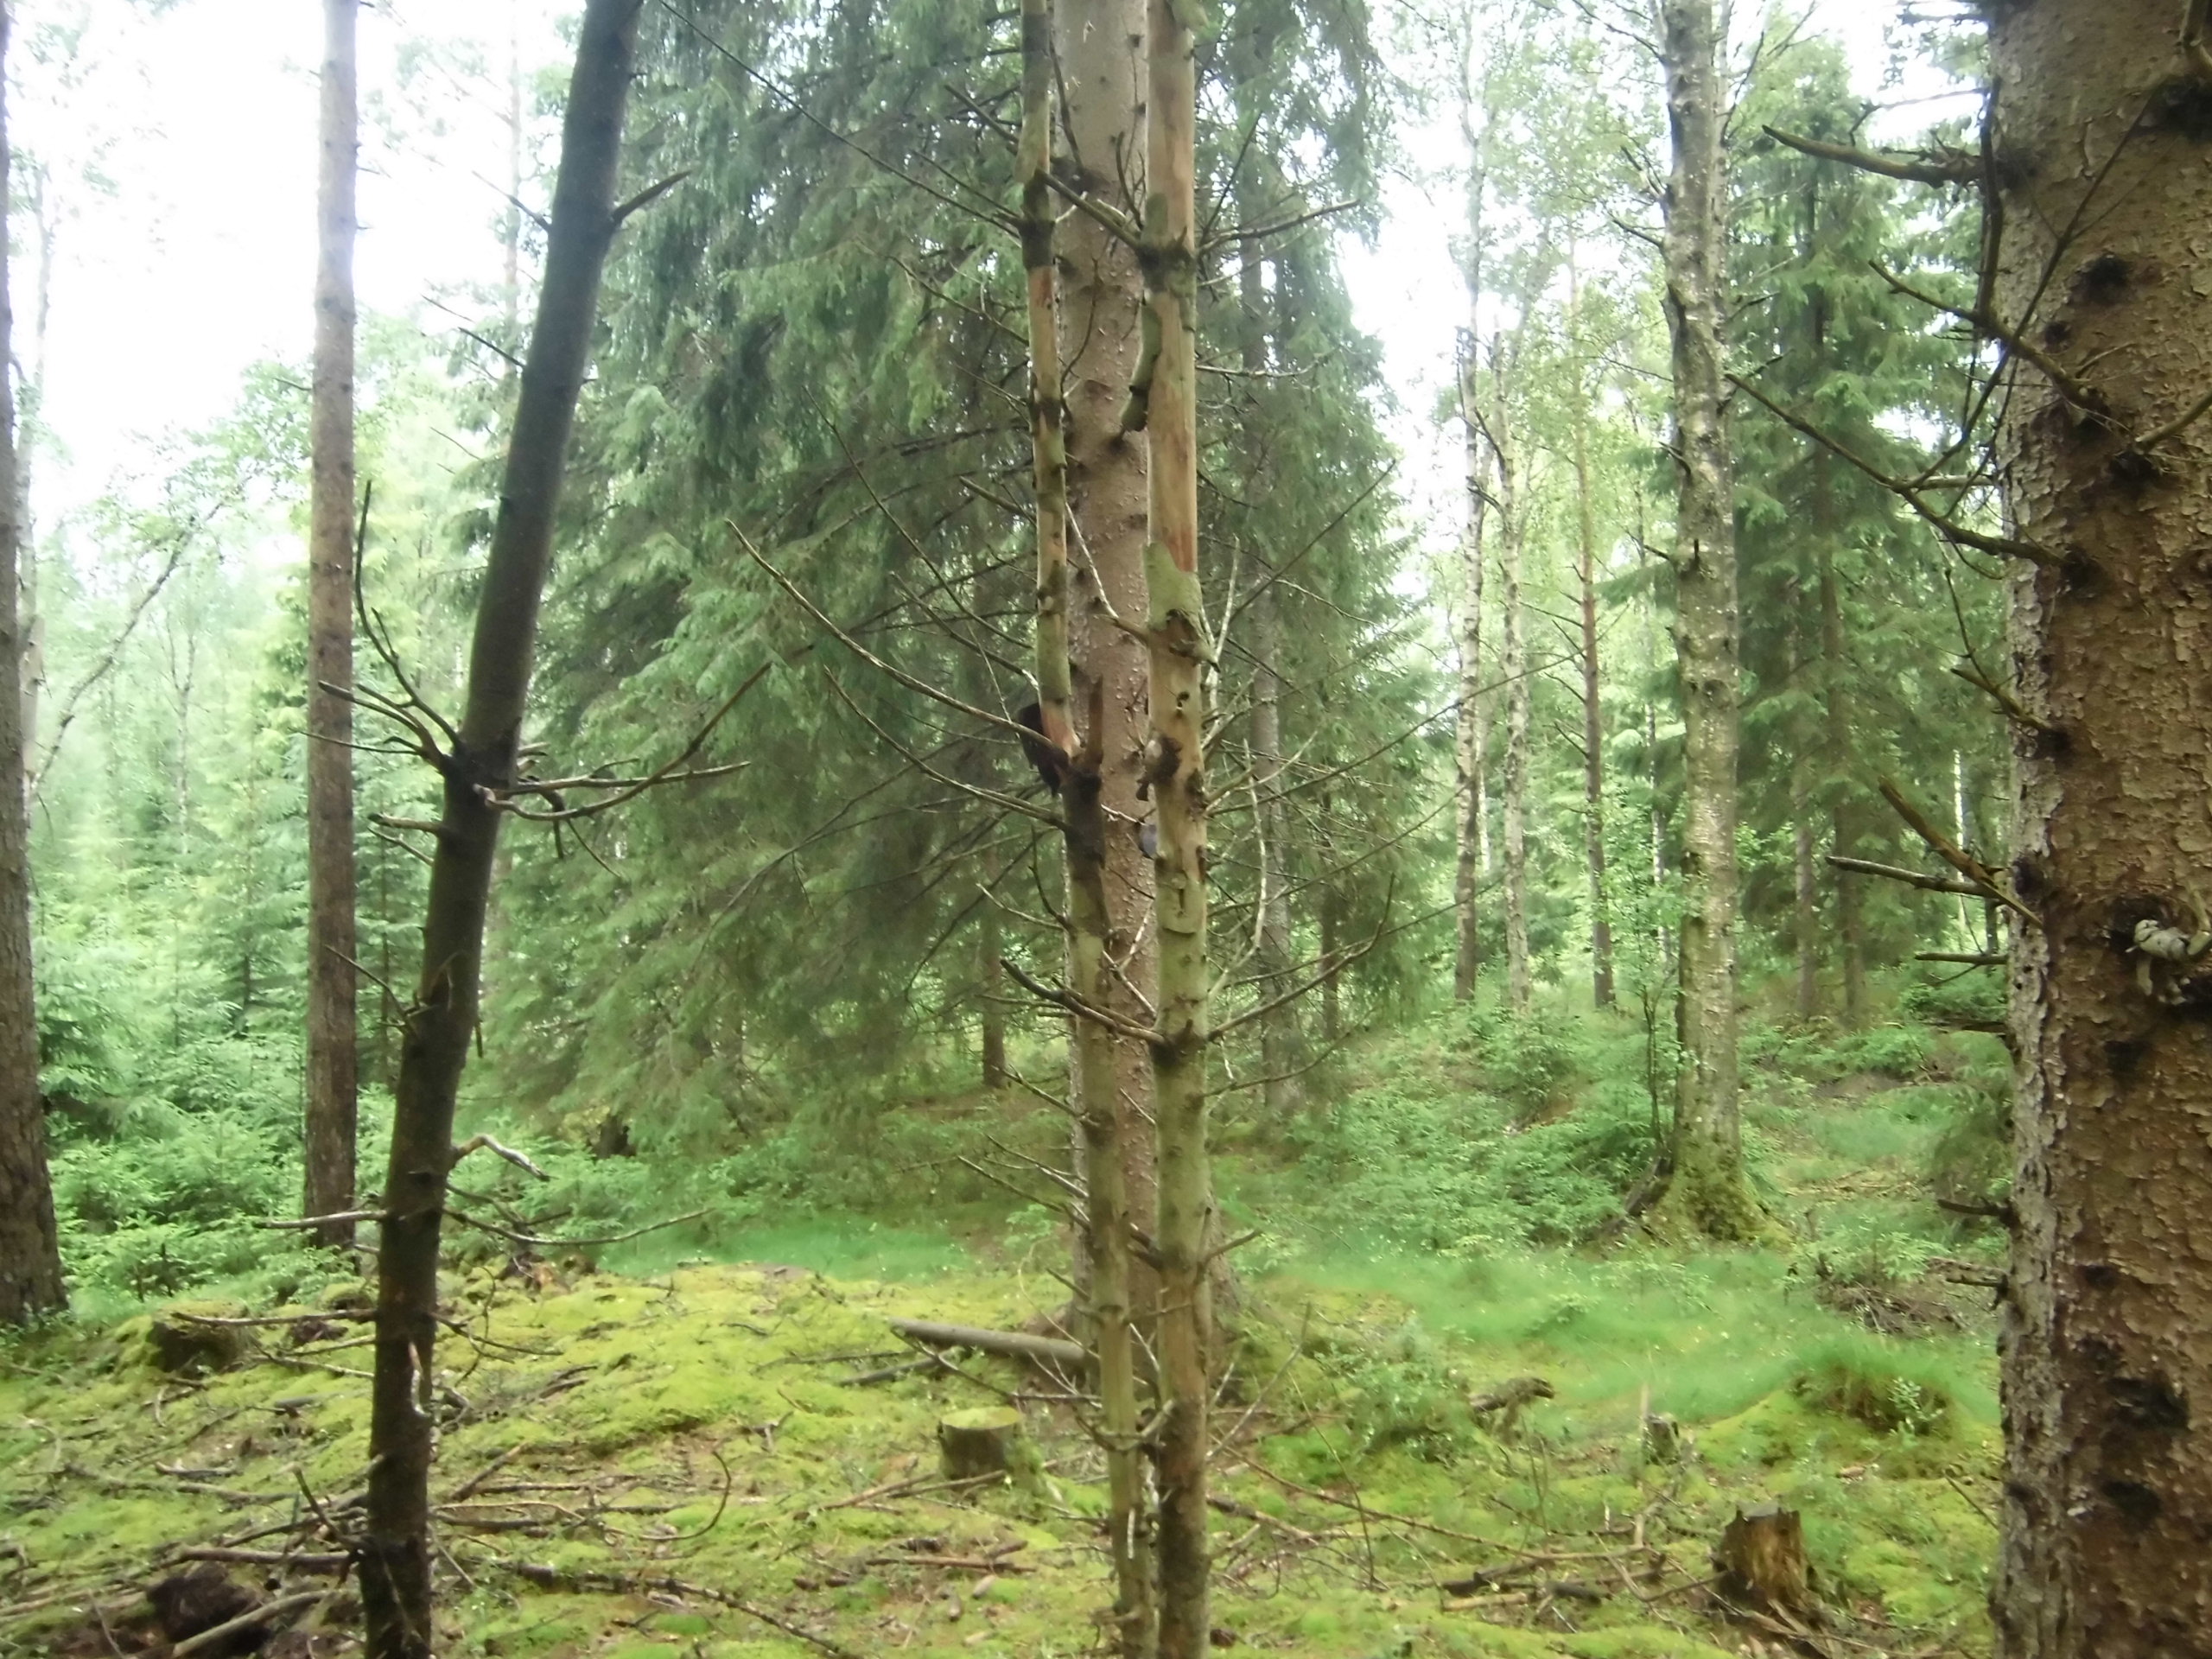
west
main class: Woodland
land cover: Spruce dominated coniferous woodland
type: boreal forest
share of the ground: 50 - 75 %
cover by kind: coniferous forest trees 60 %, lichens and mosses 20 %, herbaceous plants 10 %, broadleaved forest trees 5 %, shrubs 5 %
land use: Forestry
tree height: > 5 m
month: July
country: SE
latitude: 57.1236
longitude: 15.2994
